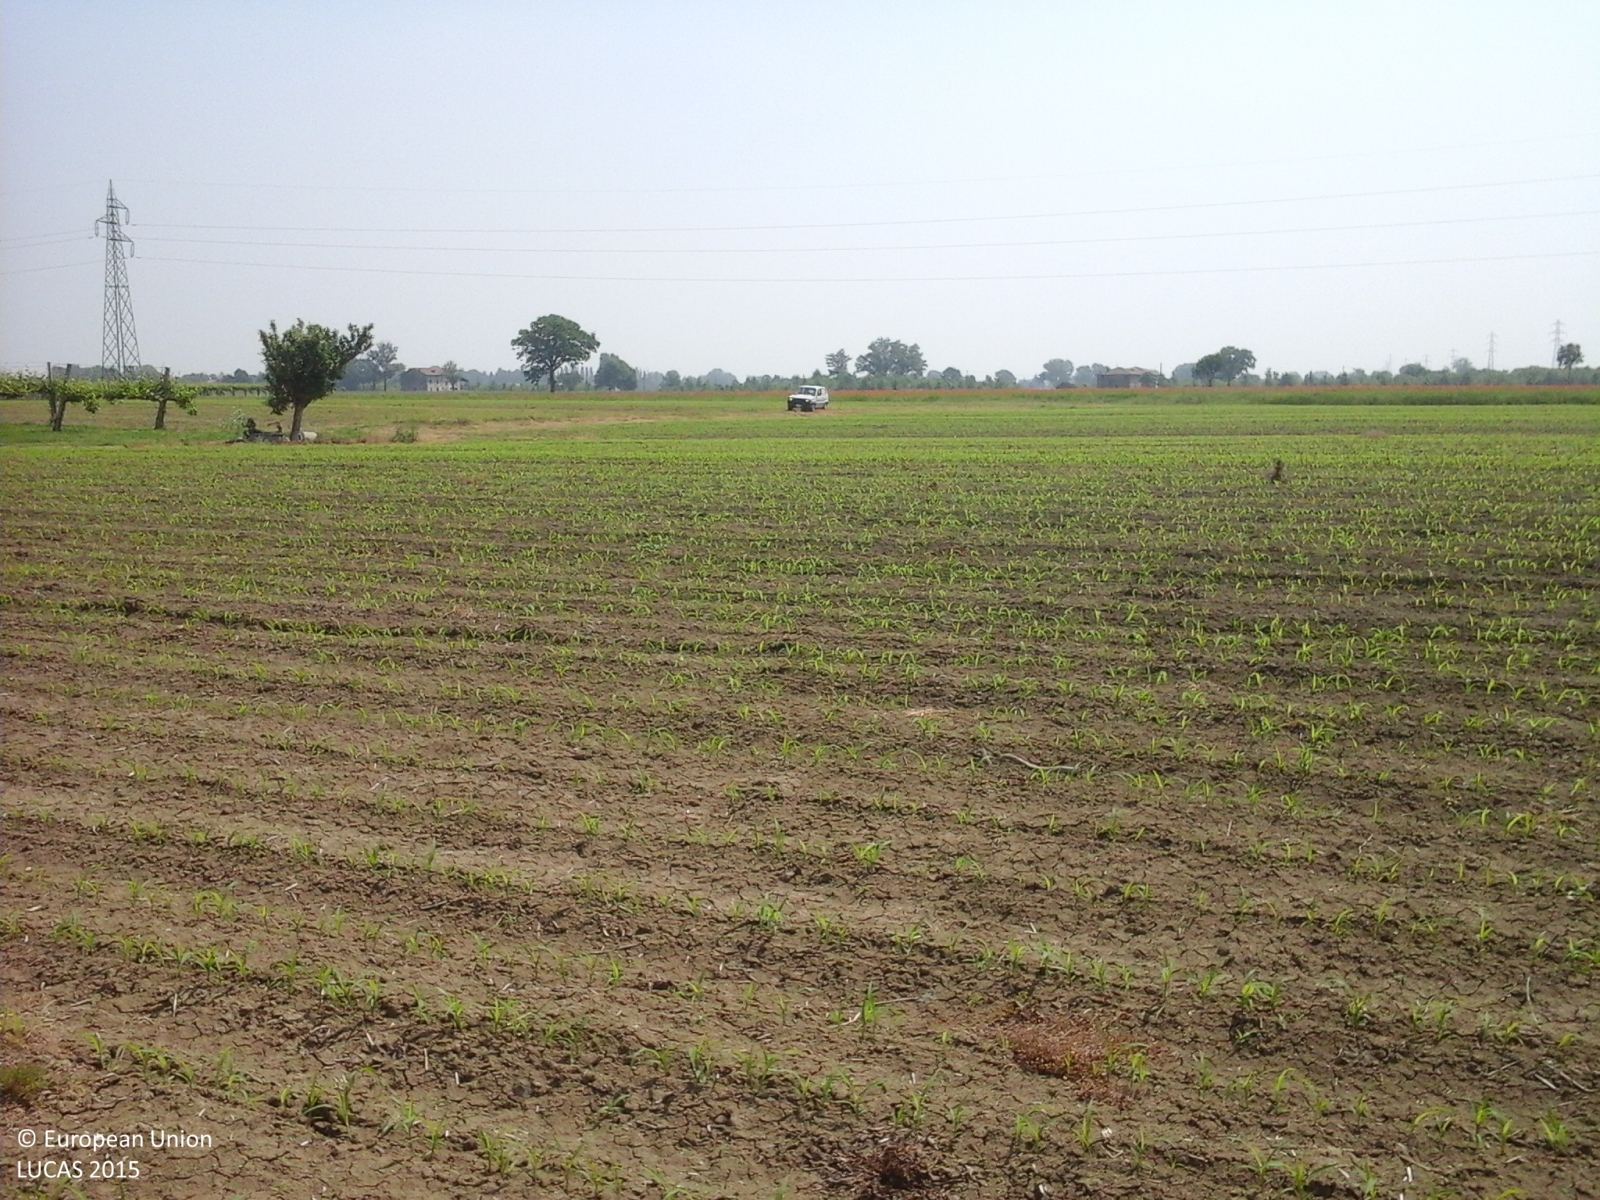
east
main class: Cropland
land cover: Other cereals
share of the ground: < 10 %
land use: Agriculture (excluding fallow land and kitchen gardens)
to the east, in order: Grass margins; Other cereals; Ditches and canals; Other cereals; Grass margins; Other cereals; Grass margins; Ditches and canals; Grass margins; Tracks; Lucerne; Ditches and canals; Lucerne; Ditches and canals; Lucerne; Electric lines; Lucerne
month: May
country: IT
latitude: 44.5795
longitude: 11.0682
